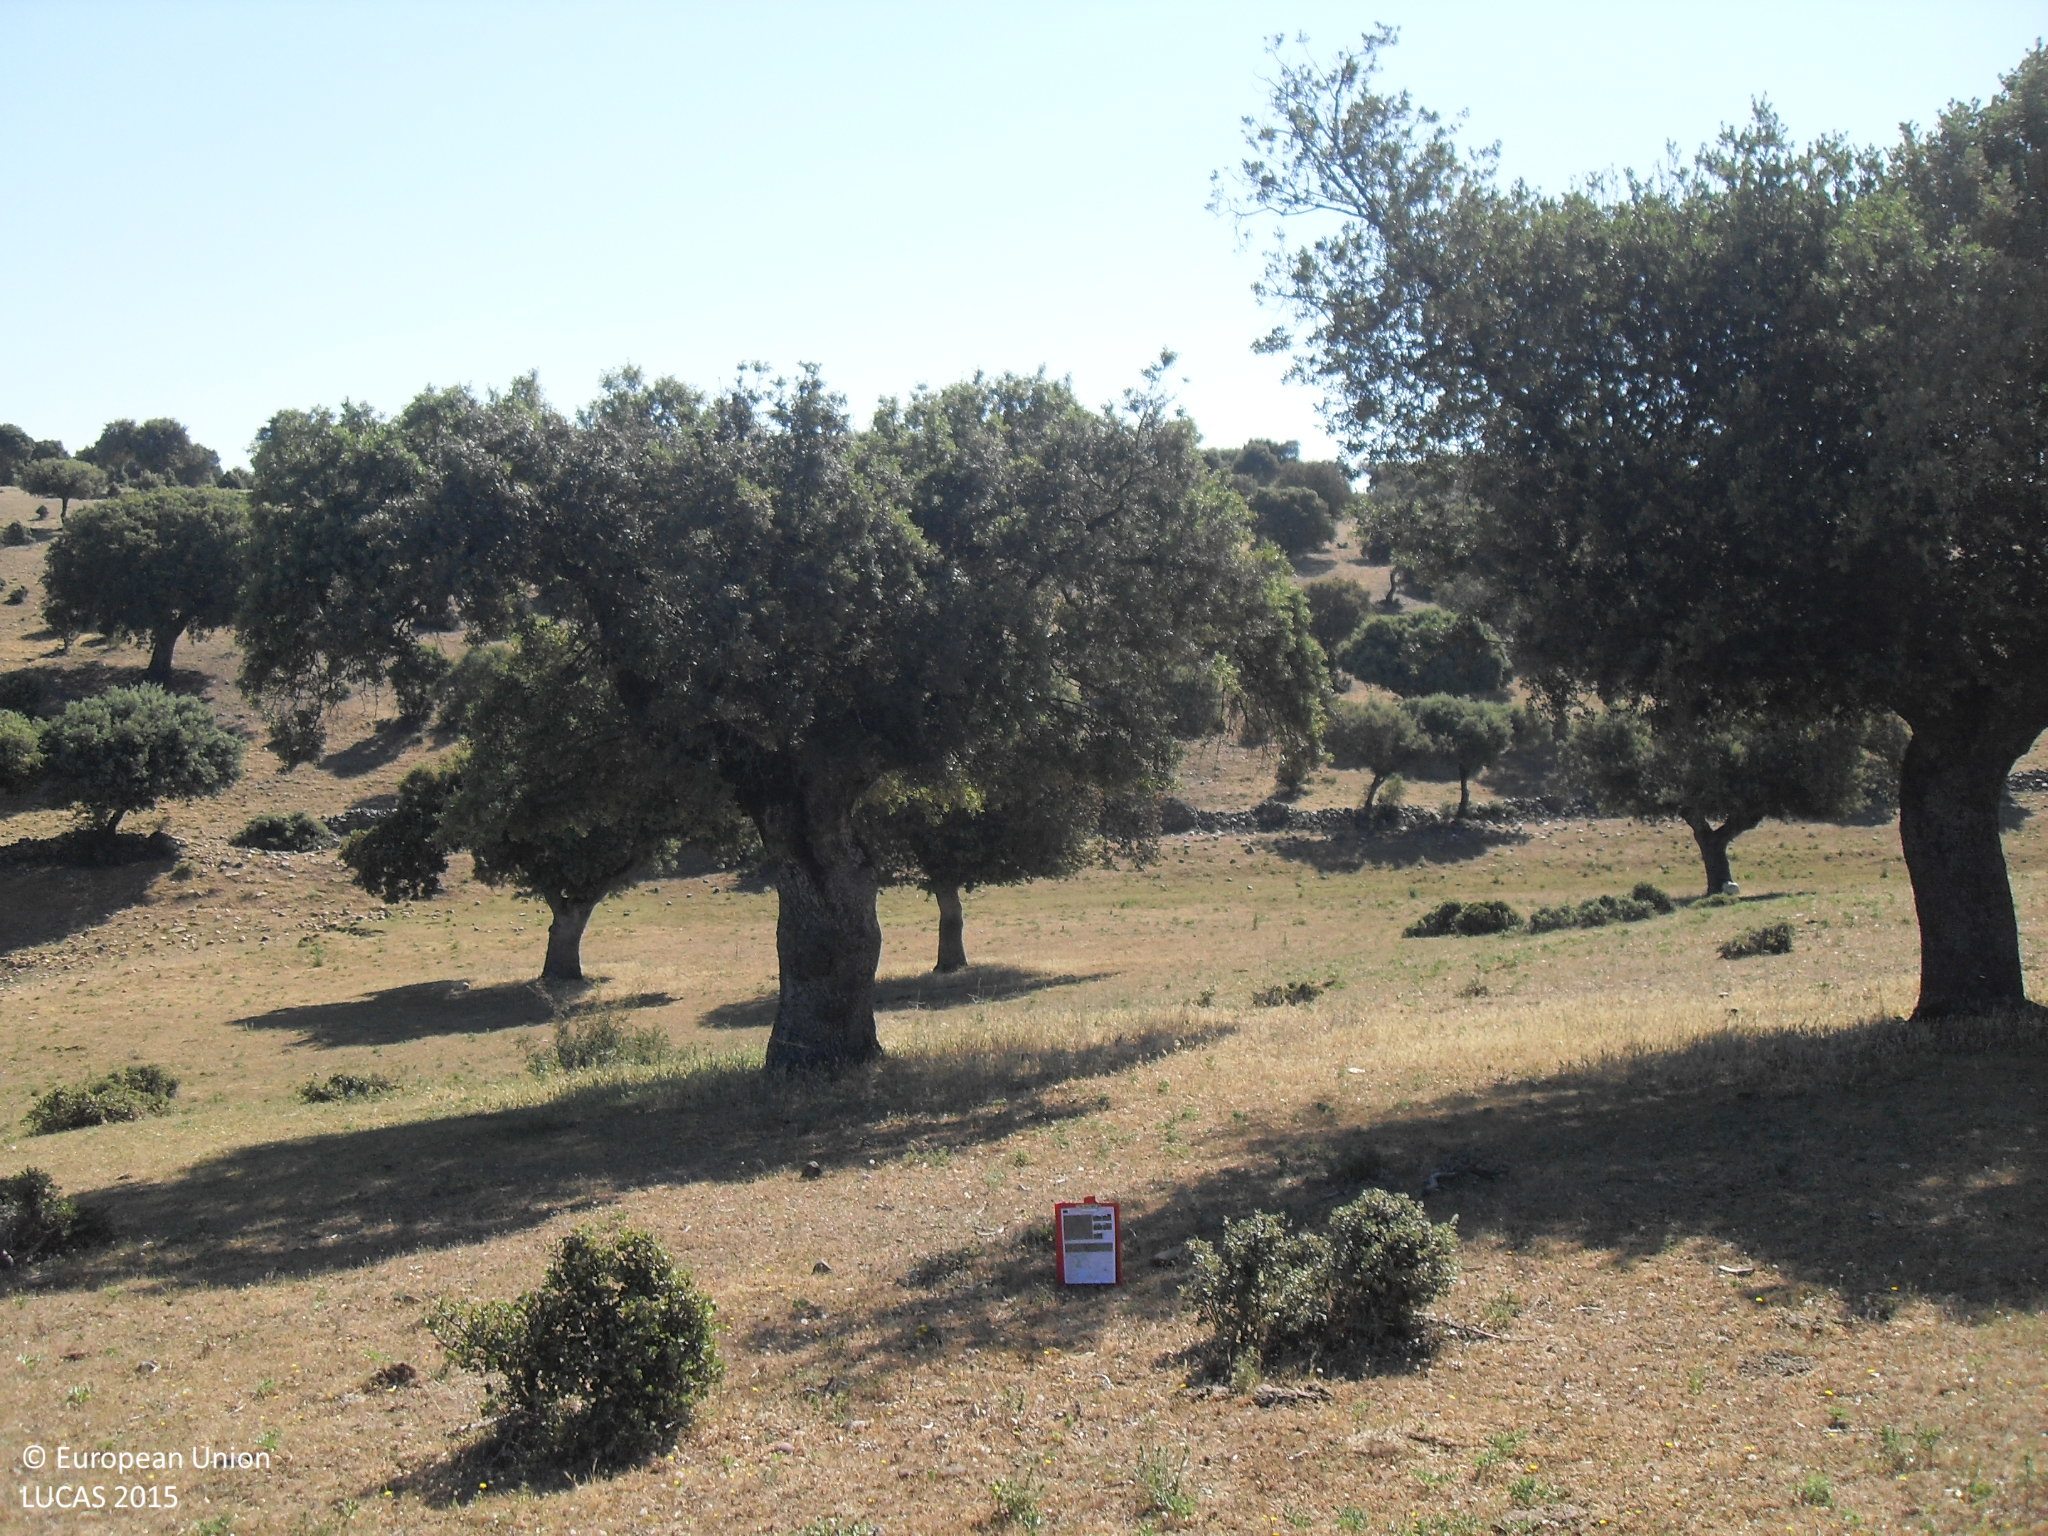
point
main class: Woodland
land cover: Broadleaved woodland
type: broadleaved evergreen forest
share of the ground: 10 - 25 %
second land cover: Grassland without tree/shrub cover
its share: > 75 %
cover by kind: herbaceous plants 80 %, broadleaved forest trees 15 %, shrubs 5 %
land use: Forestry
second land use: Agriculture (excluding fallow land and kitchen gardens)
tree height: > 5 m
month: June
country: ES
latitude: 40.6685
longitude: -5.5797
